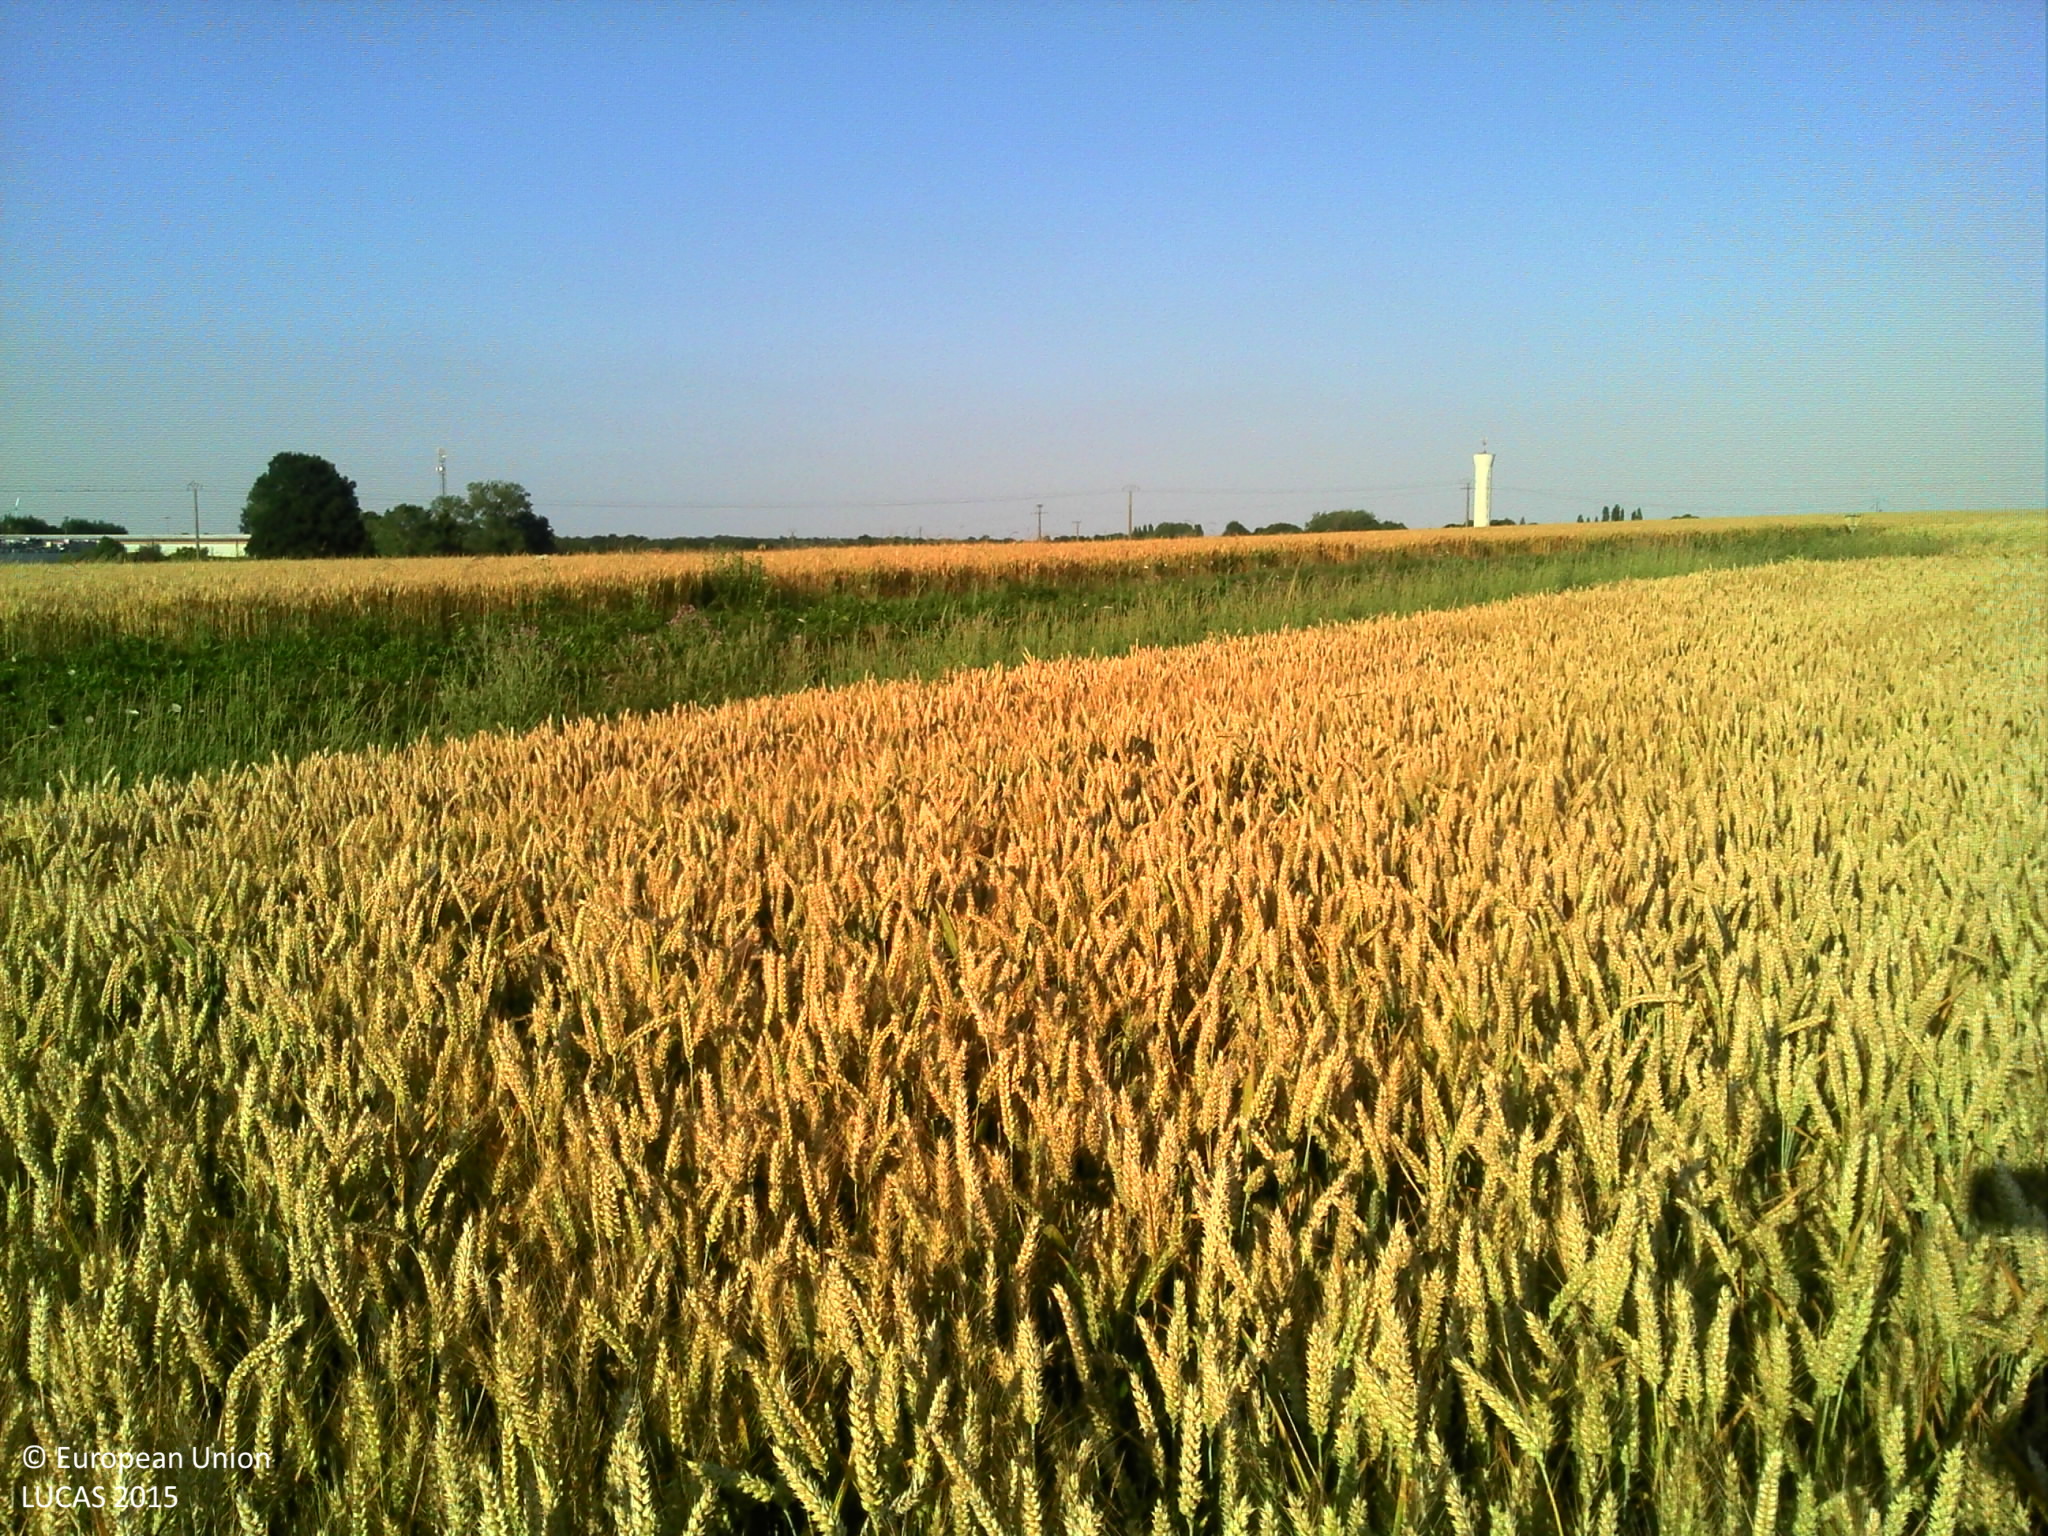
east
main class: Cropland
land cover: Common wheat
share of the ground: > 75 %
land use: Agriculture (excluding fallow land and kitchen gardens)
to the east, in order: Common wheat; Grass margins; Paved roads, cycling and walking lanes; Grass margins; Common wheat
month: July
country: FR
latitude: 49.1488
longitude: 0.6663
